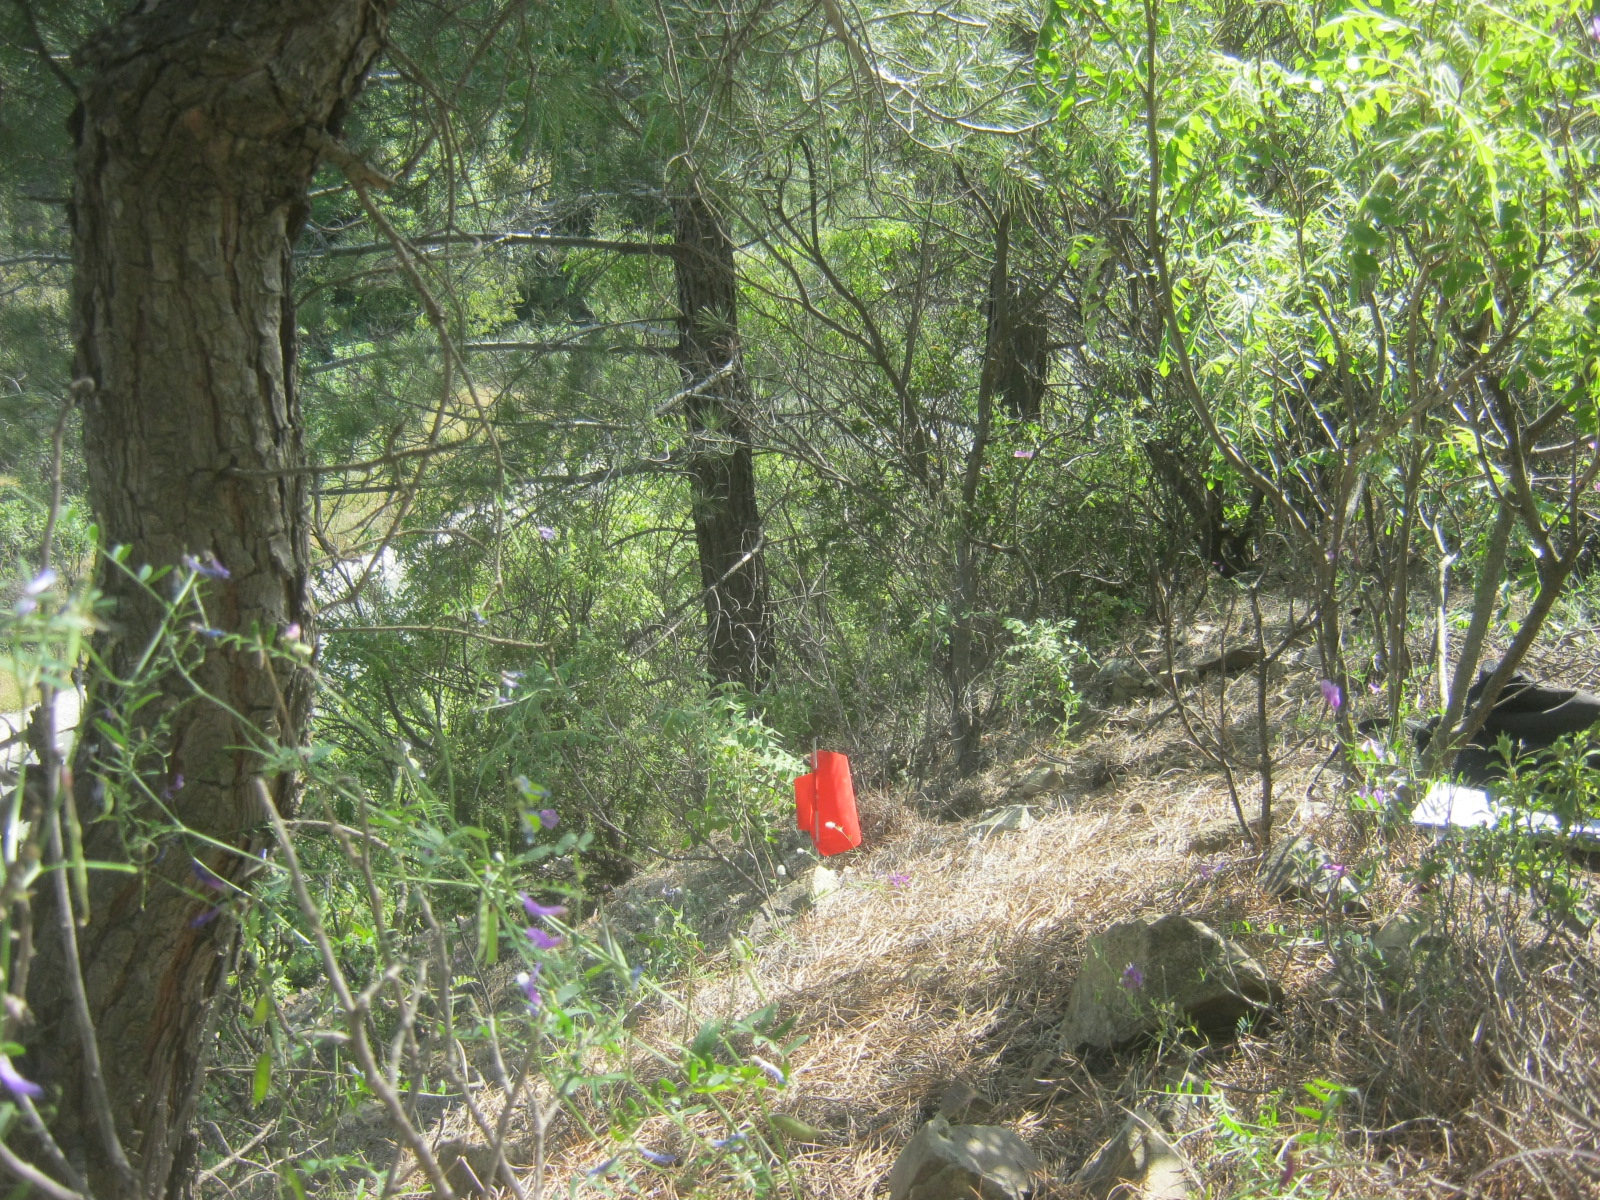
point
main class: Woodland
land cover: Pine dominated coniferous woodland
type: coniferous forest of the mediterranean region
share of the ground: 50 - 75 %
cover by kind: coniferous forest trees 50 %, unconsolidated bare surface 20 %, herbaceous plants 15 %, shrubs 10 %, broadleaved forest trees 5 %
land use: Semi-natural and natural areas not in use
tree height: > 5 m
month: May
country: CY
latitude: 34.9572
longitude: 32.8006
